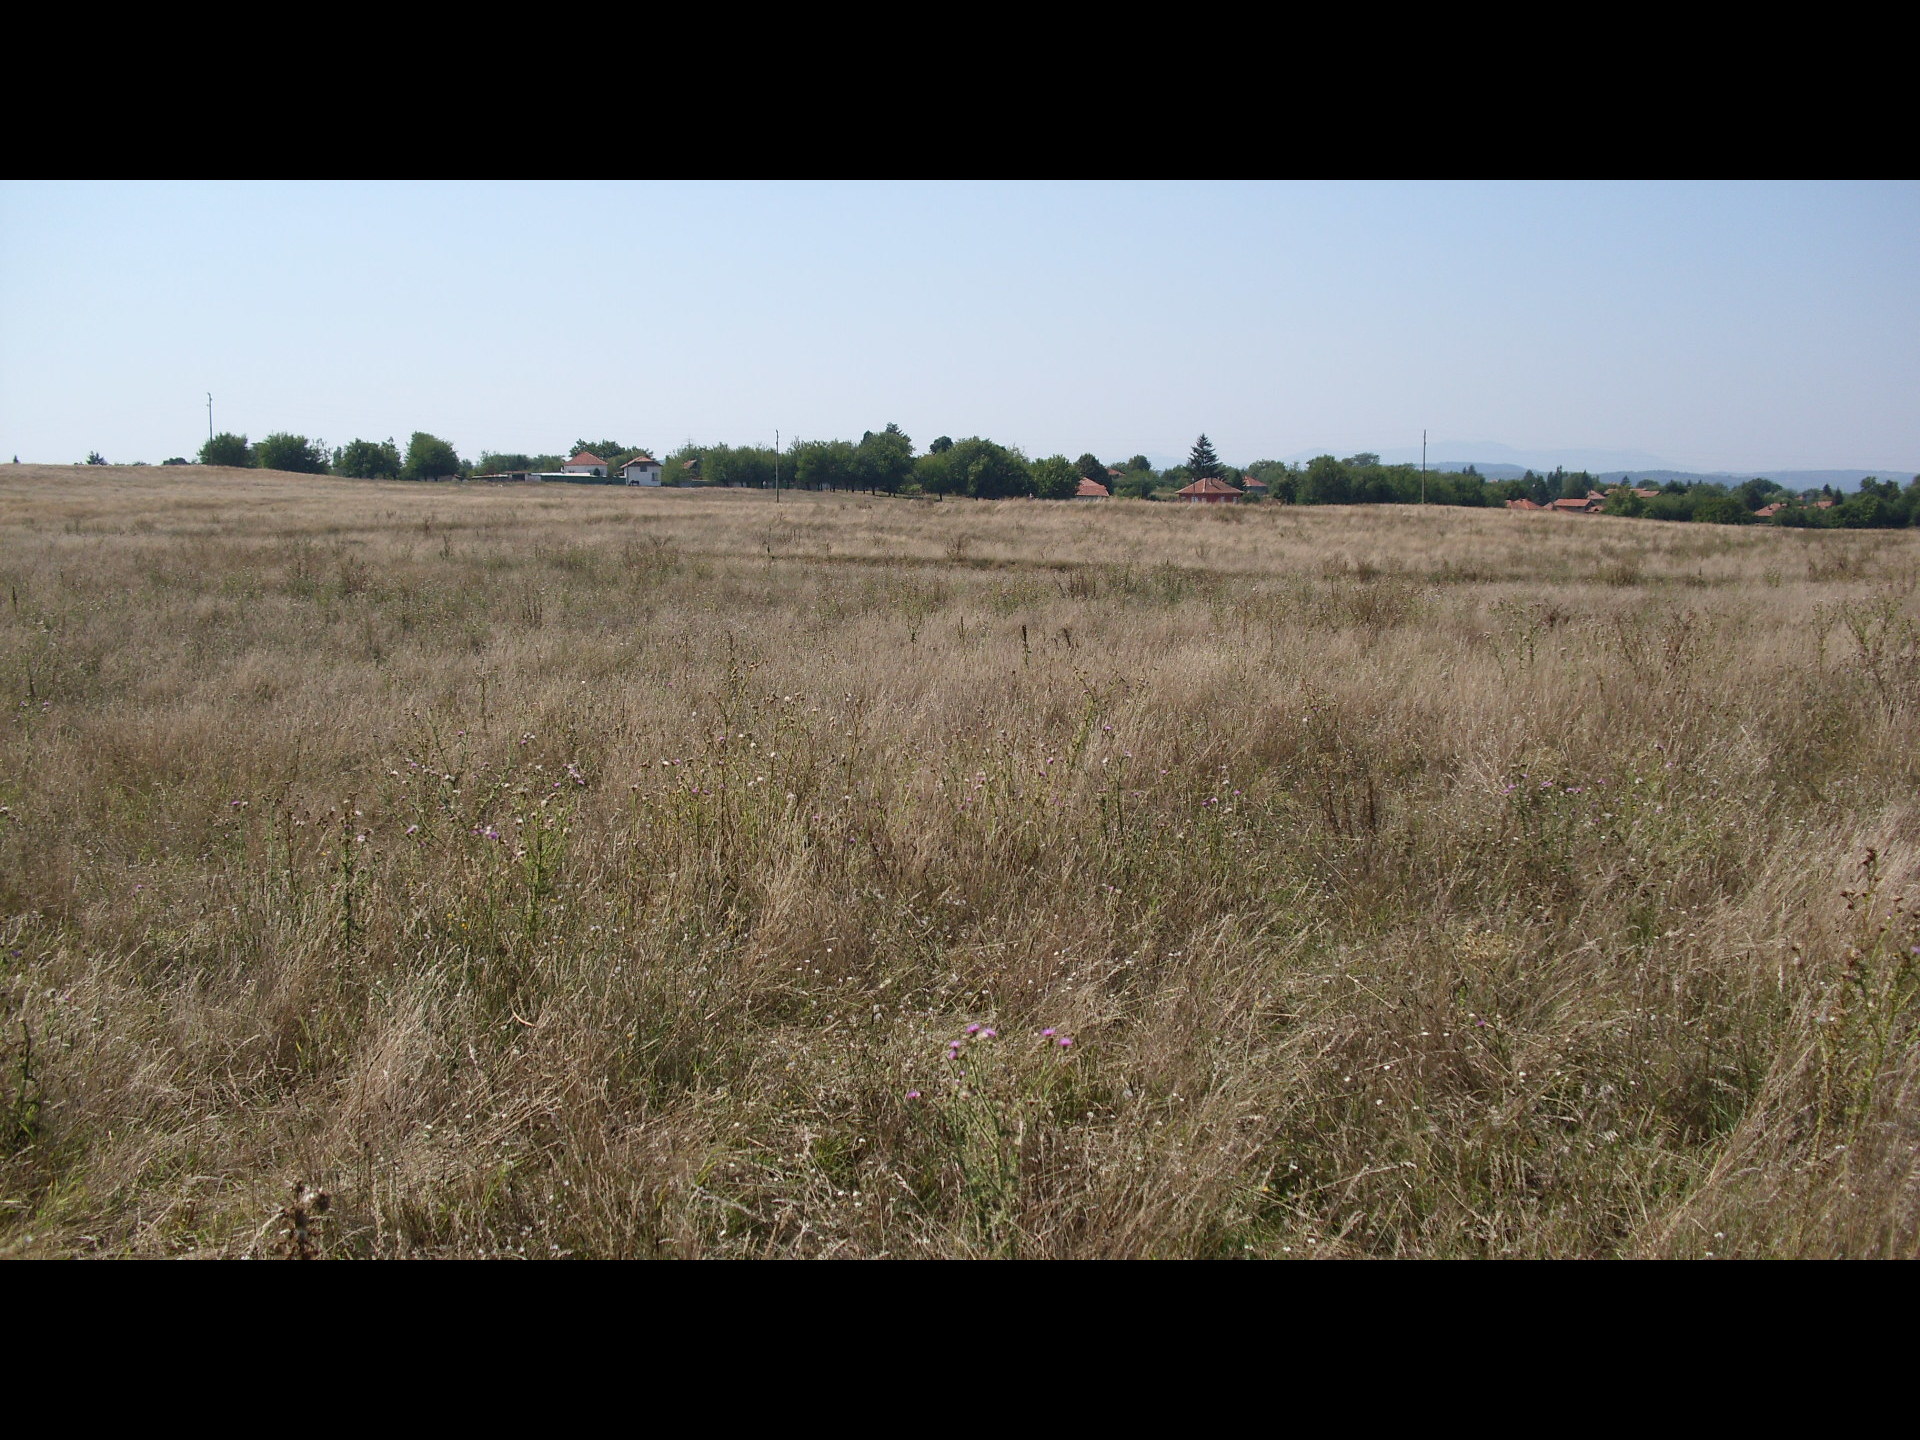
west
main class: Grassland
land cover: Grassland without tree/shrub cover
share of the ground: > 75 %
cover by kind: herbaceous plants 100 %
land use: Agriculture (excluding fallow land and kitchen gardens)
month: August
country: BG
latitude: 44.1561
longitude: 22.6540
